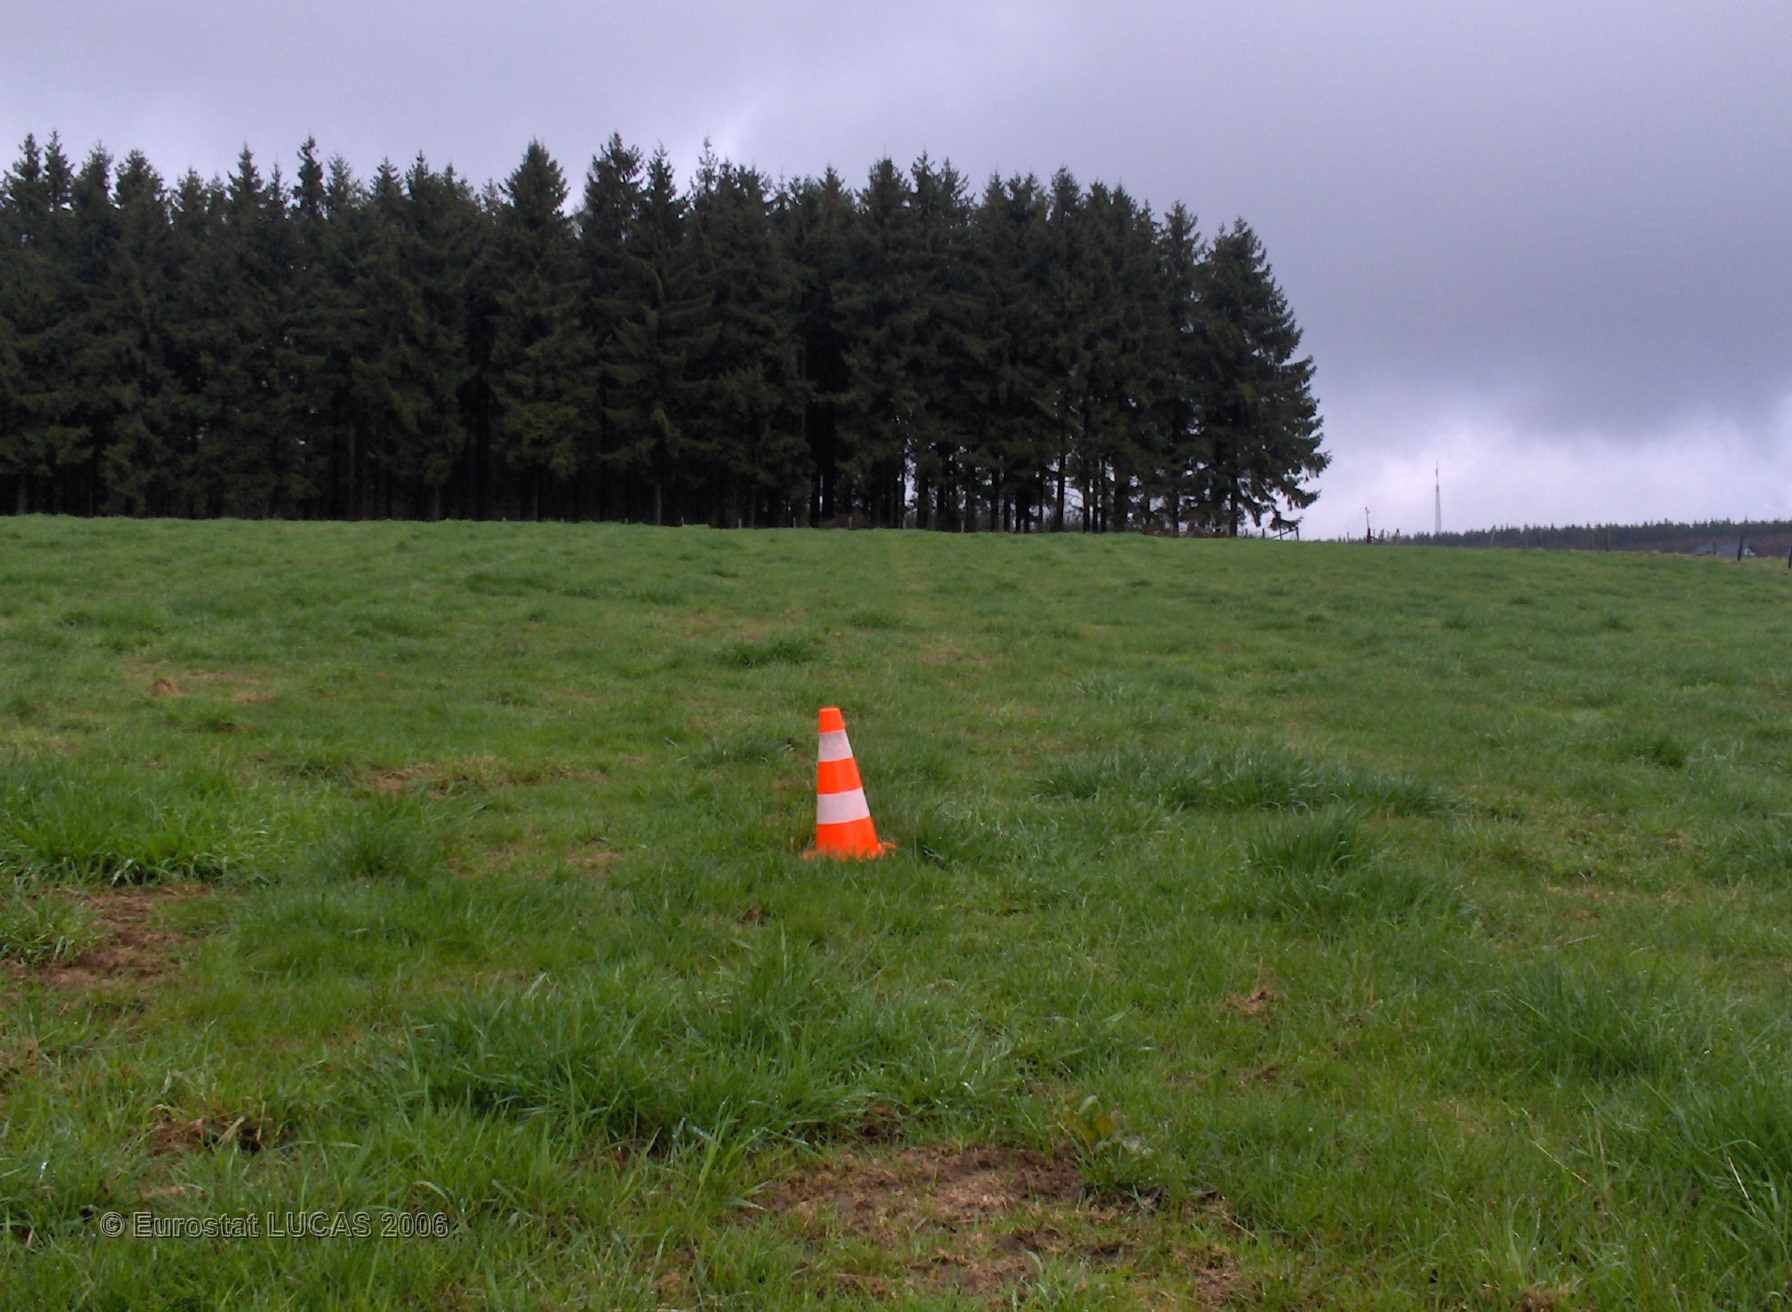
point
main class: Grassland
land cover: Grassland without tree/shrub cover
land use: Agriculture (excluding fallow land and kitchen gardens)
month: May
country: BE
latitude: 50.3592
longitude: 6.3307
